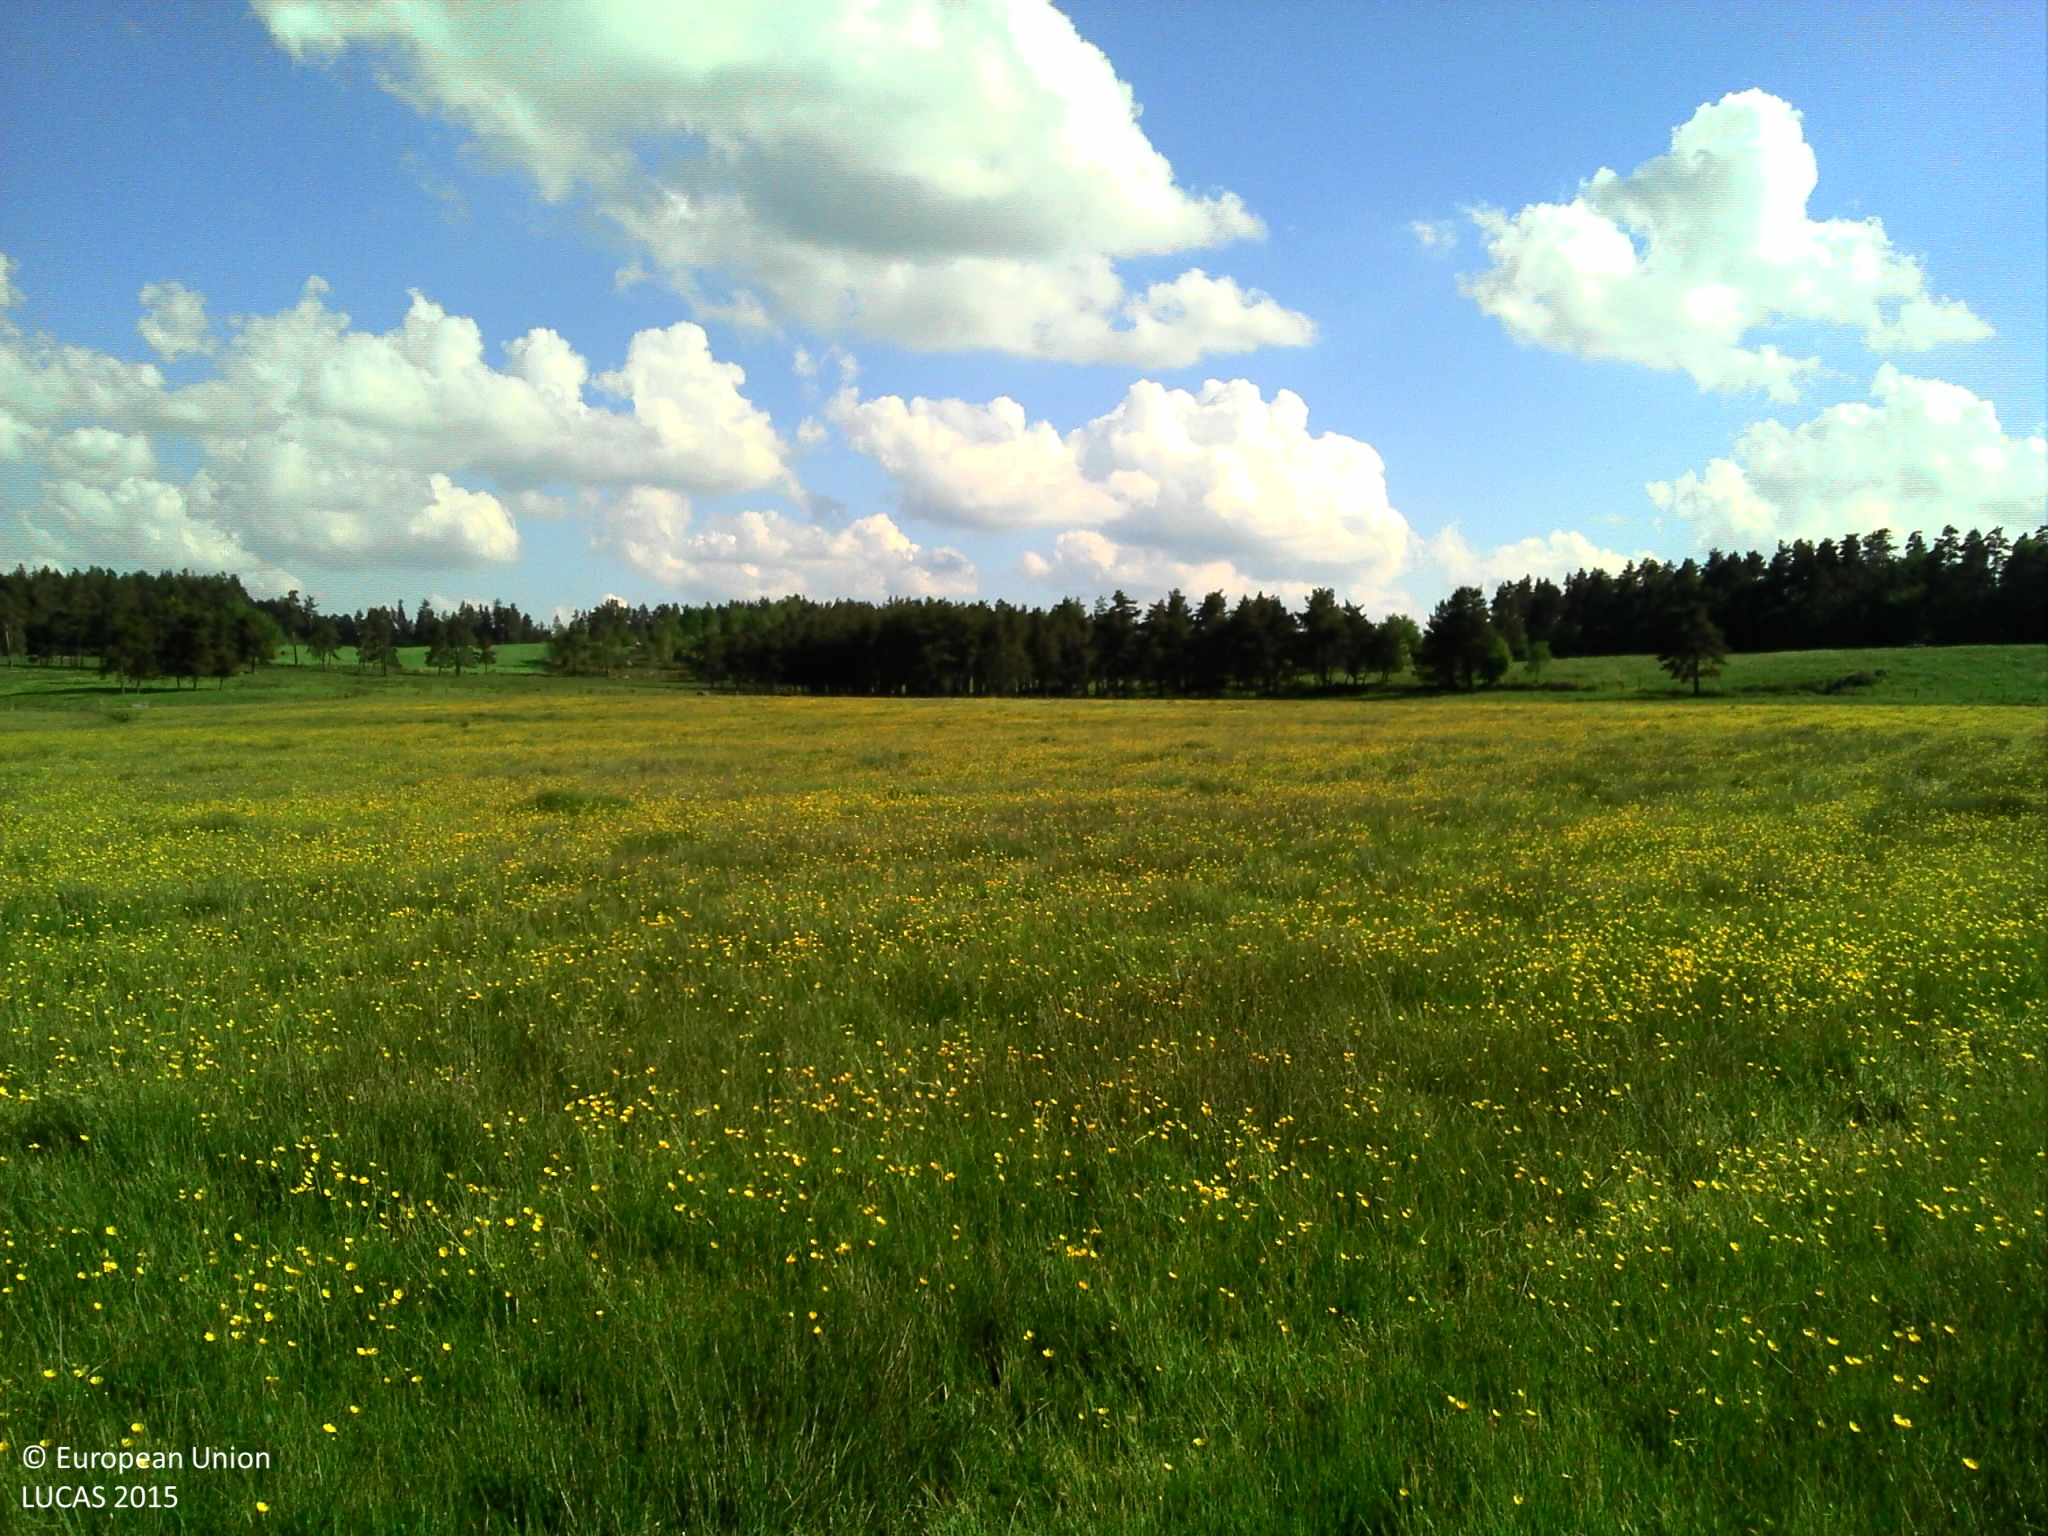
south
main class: Grassland
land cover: Grassland without tree/shrub cover
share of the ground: > 75 %
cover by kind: herbaceous plants 100 %
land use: Agriculture (excluding fallow land and kitchen gardens)
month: June
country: FR
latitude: 44.7794
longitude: 2.9384
